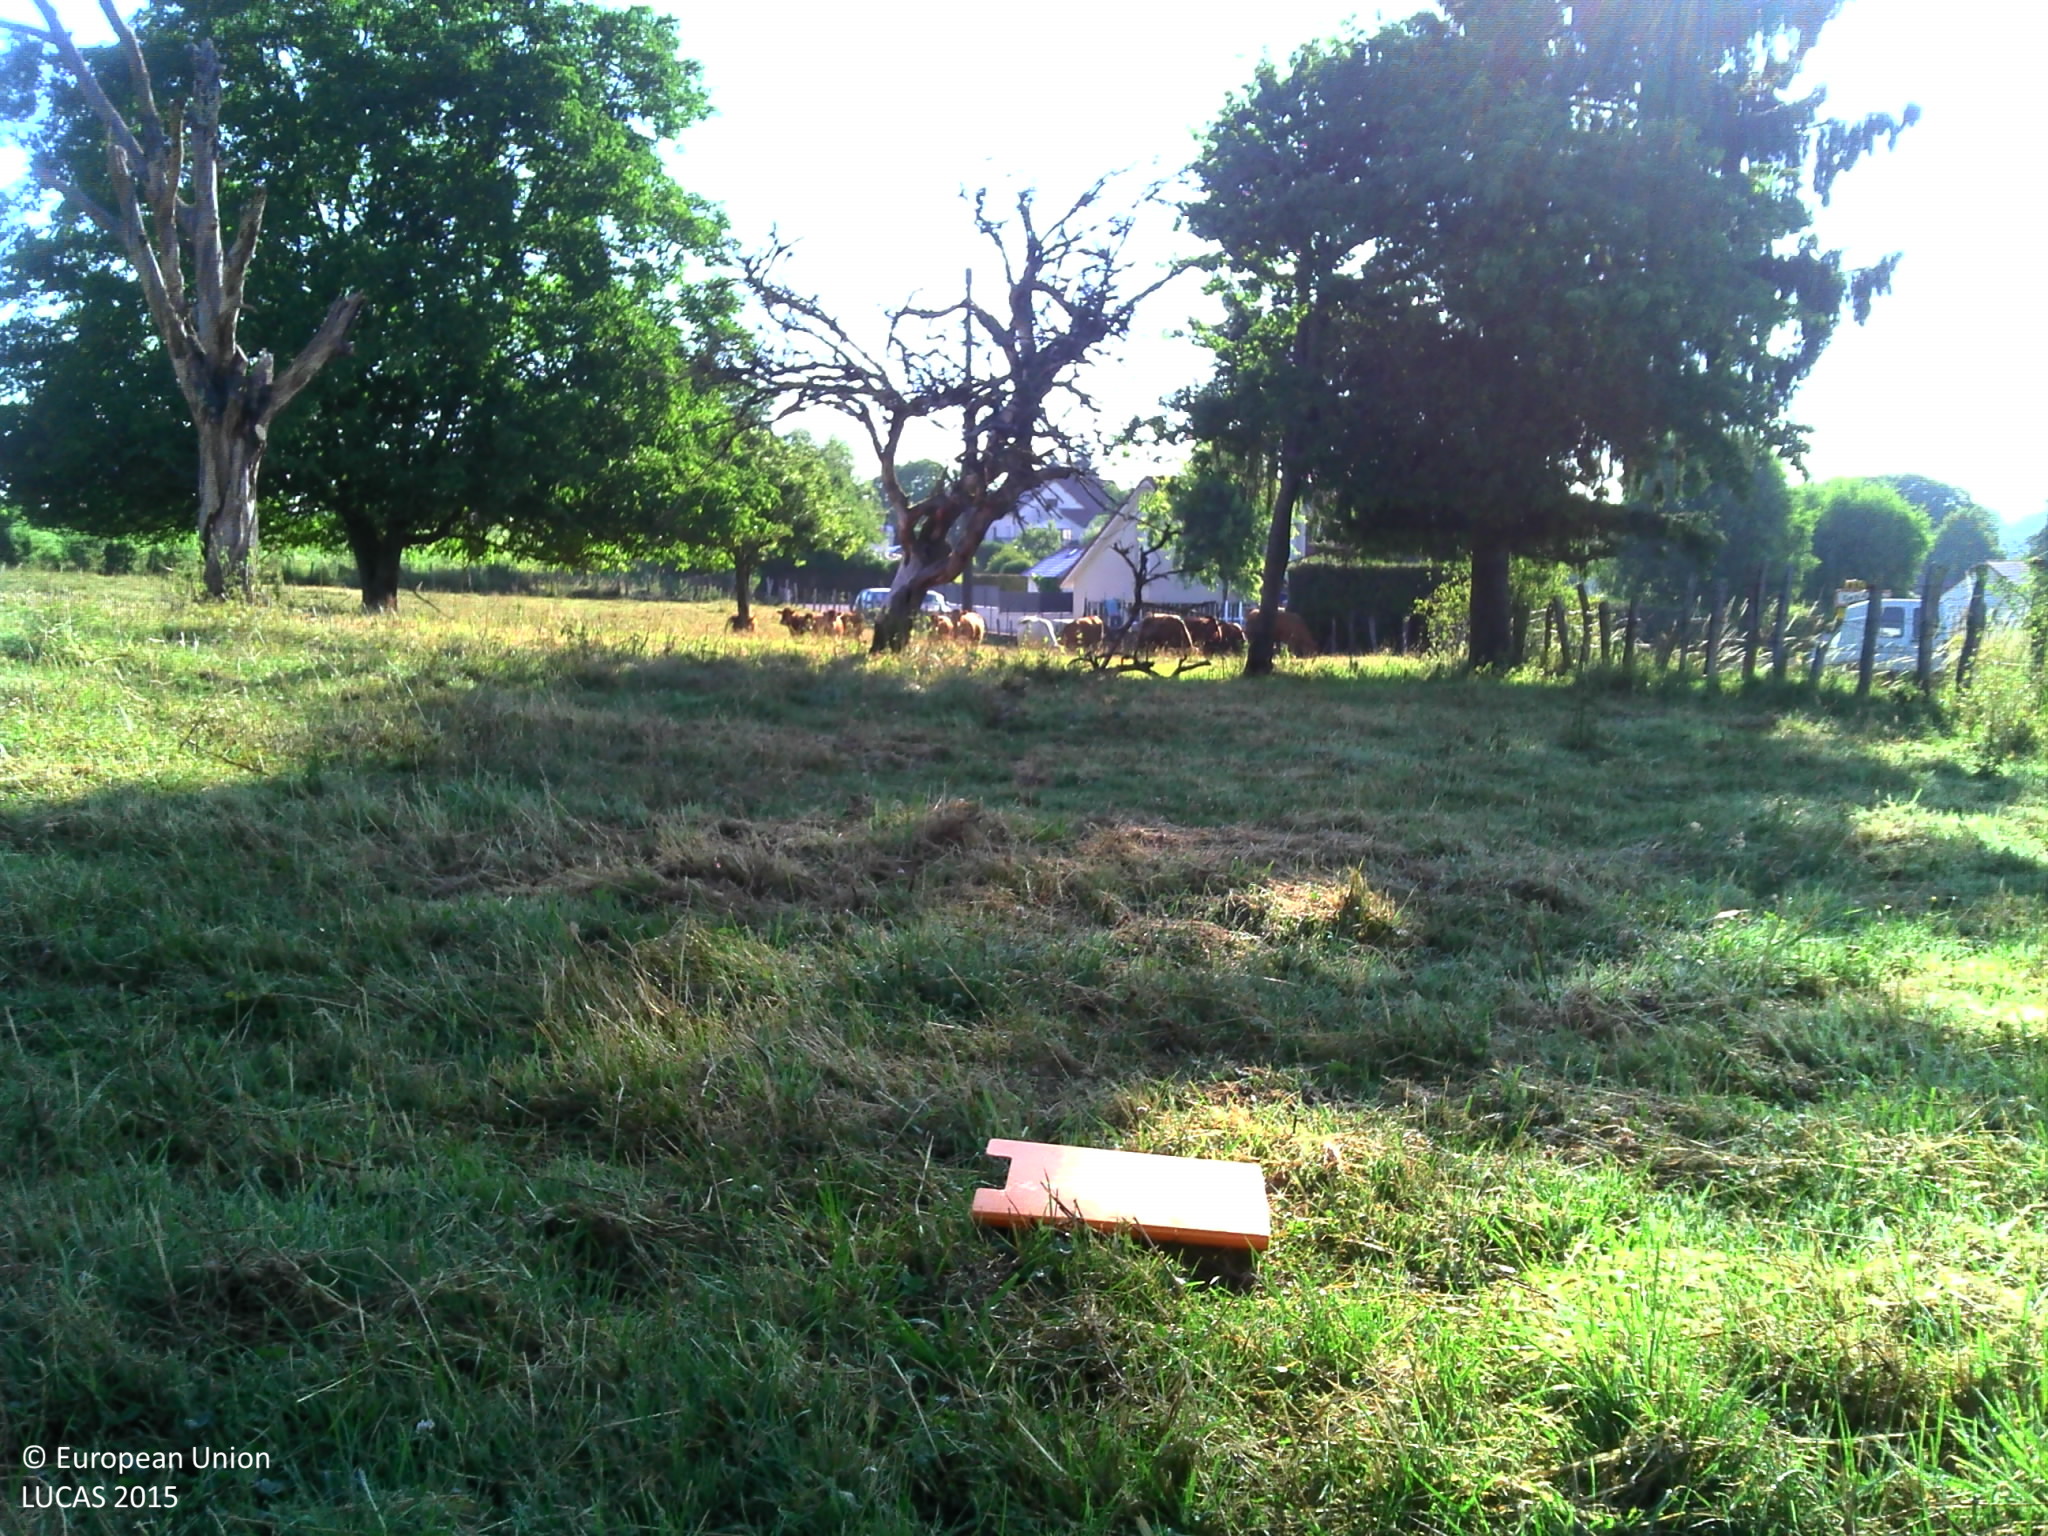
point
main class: Grassland
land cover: Grassland without tree/shrub cover
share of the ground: > 75 %
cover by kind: herbaceous plants 100 %
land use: Agriculture (excluding fallow land and kitchen gardens)
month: June
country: FR
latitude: 47.3606
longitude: 6.0692
